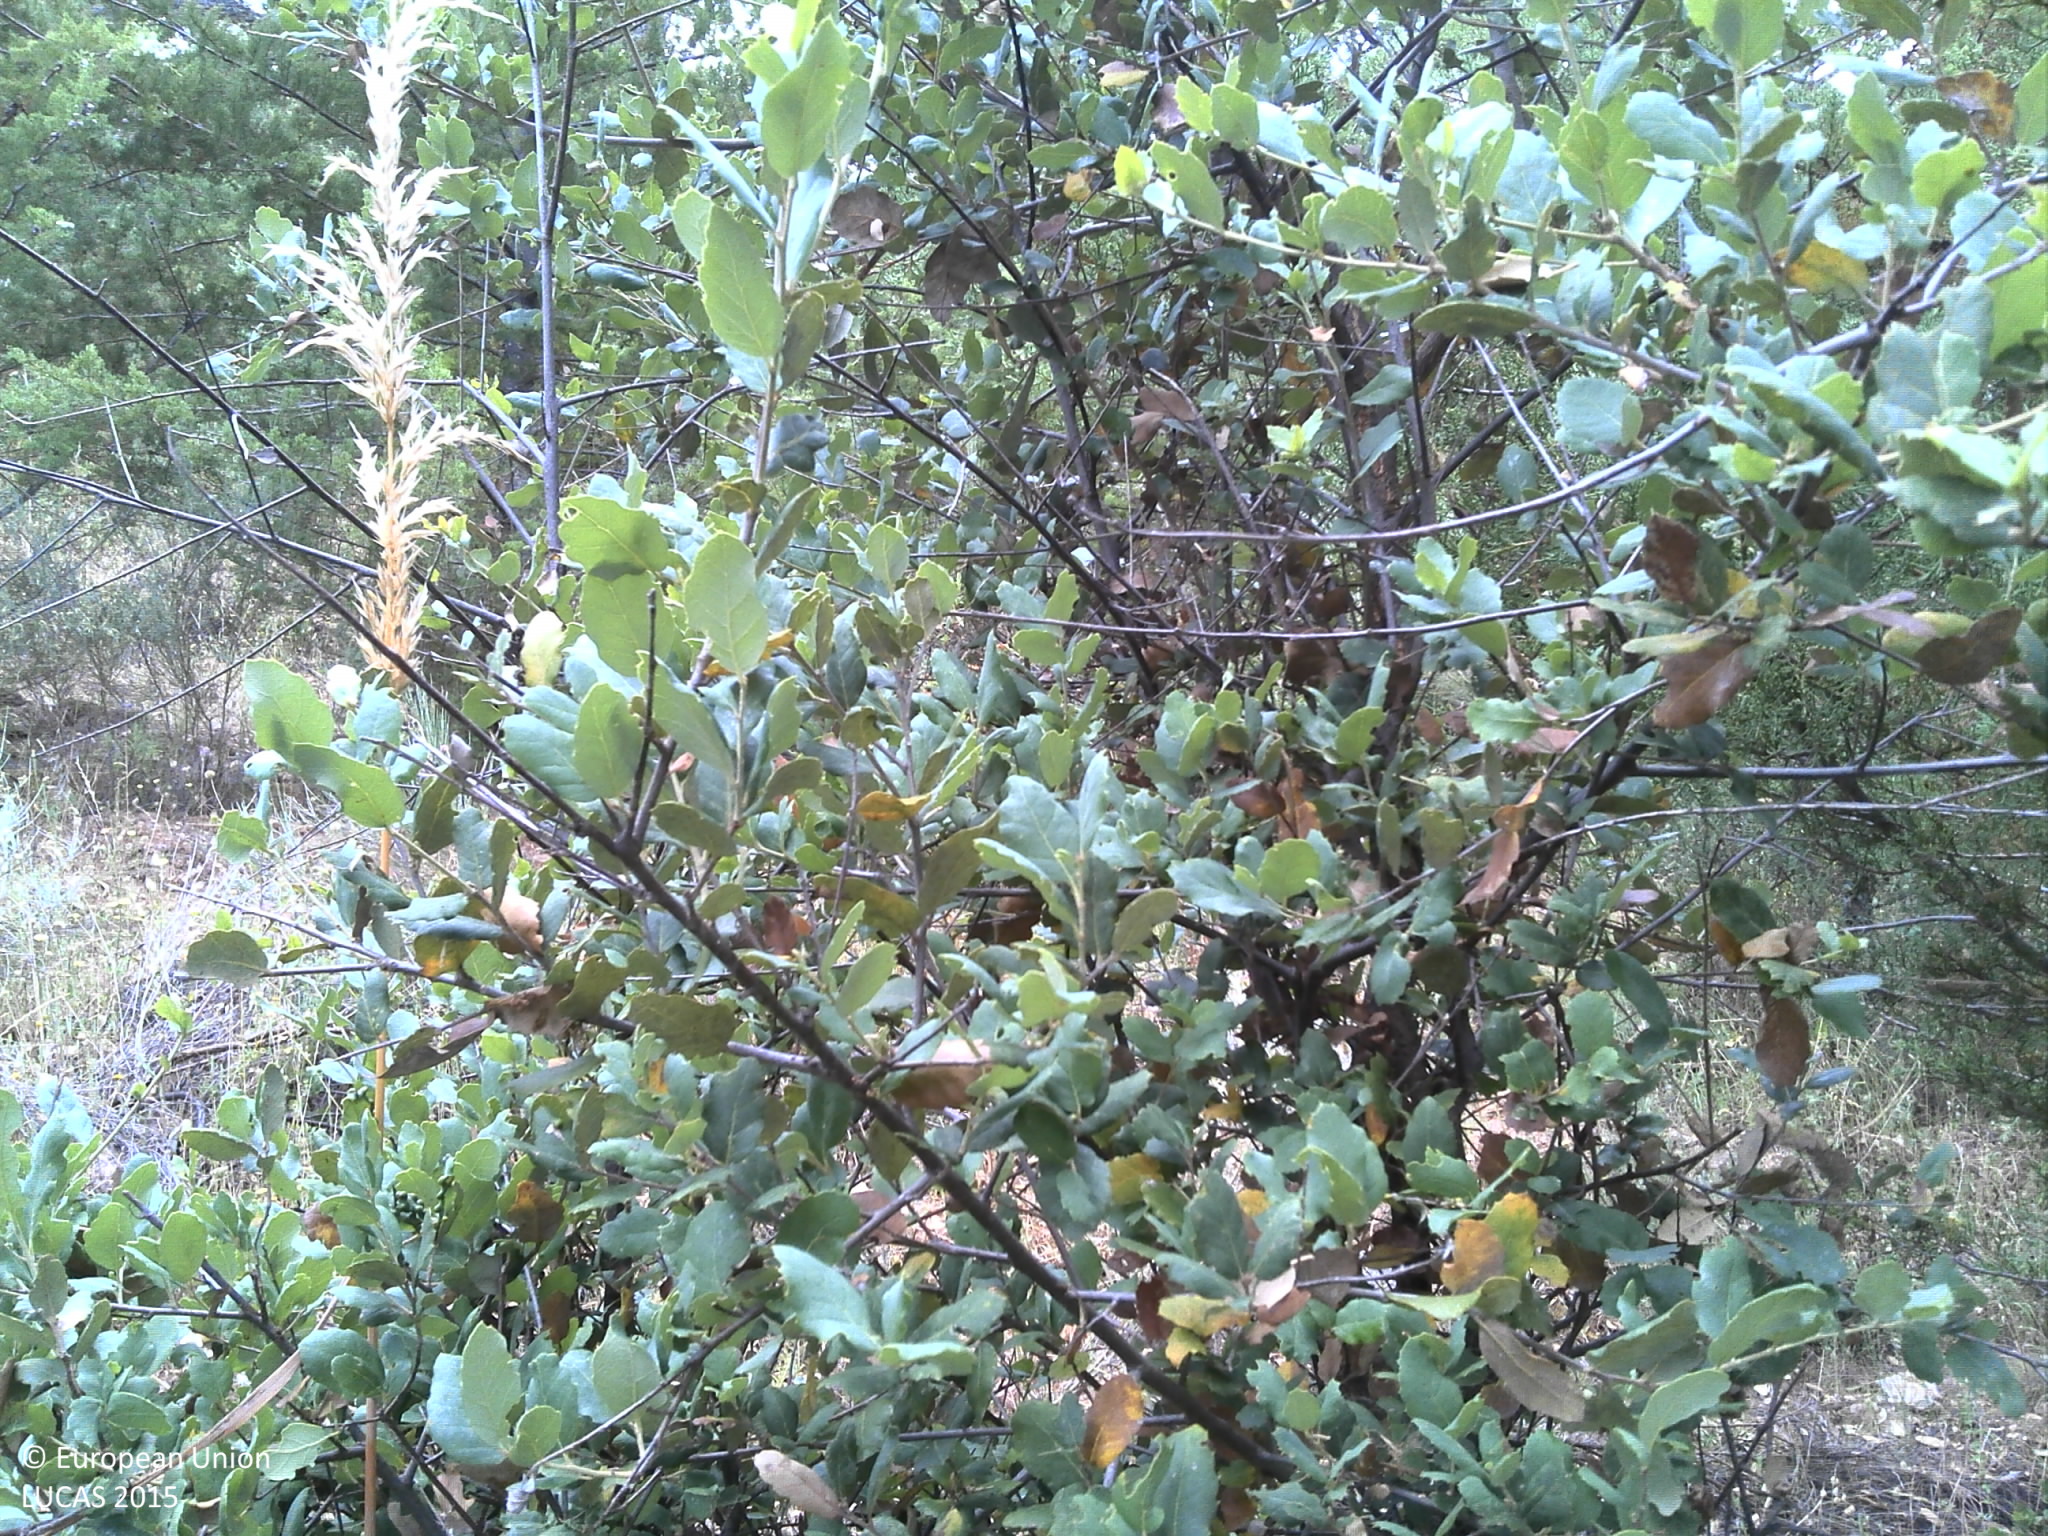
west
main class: Woodland
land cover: Other coniferous woodland
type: coniferous forest of the mediterranean region
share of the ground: < 10 %
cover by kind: shrubs 45 %, herbaceous plants 45 %, coniferous forest trees 10 %
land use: Forestry
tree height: > 5 m
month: June
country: PT
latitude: 41.2990
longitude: -6.9861
